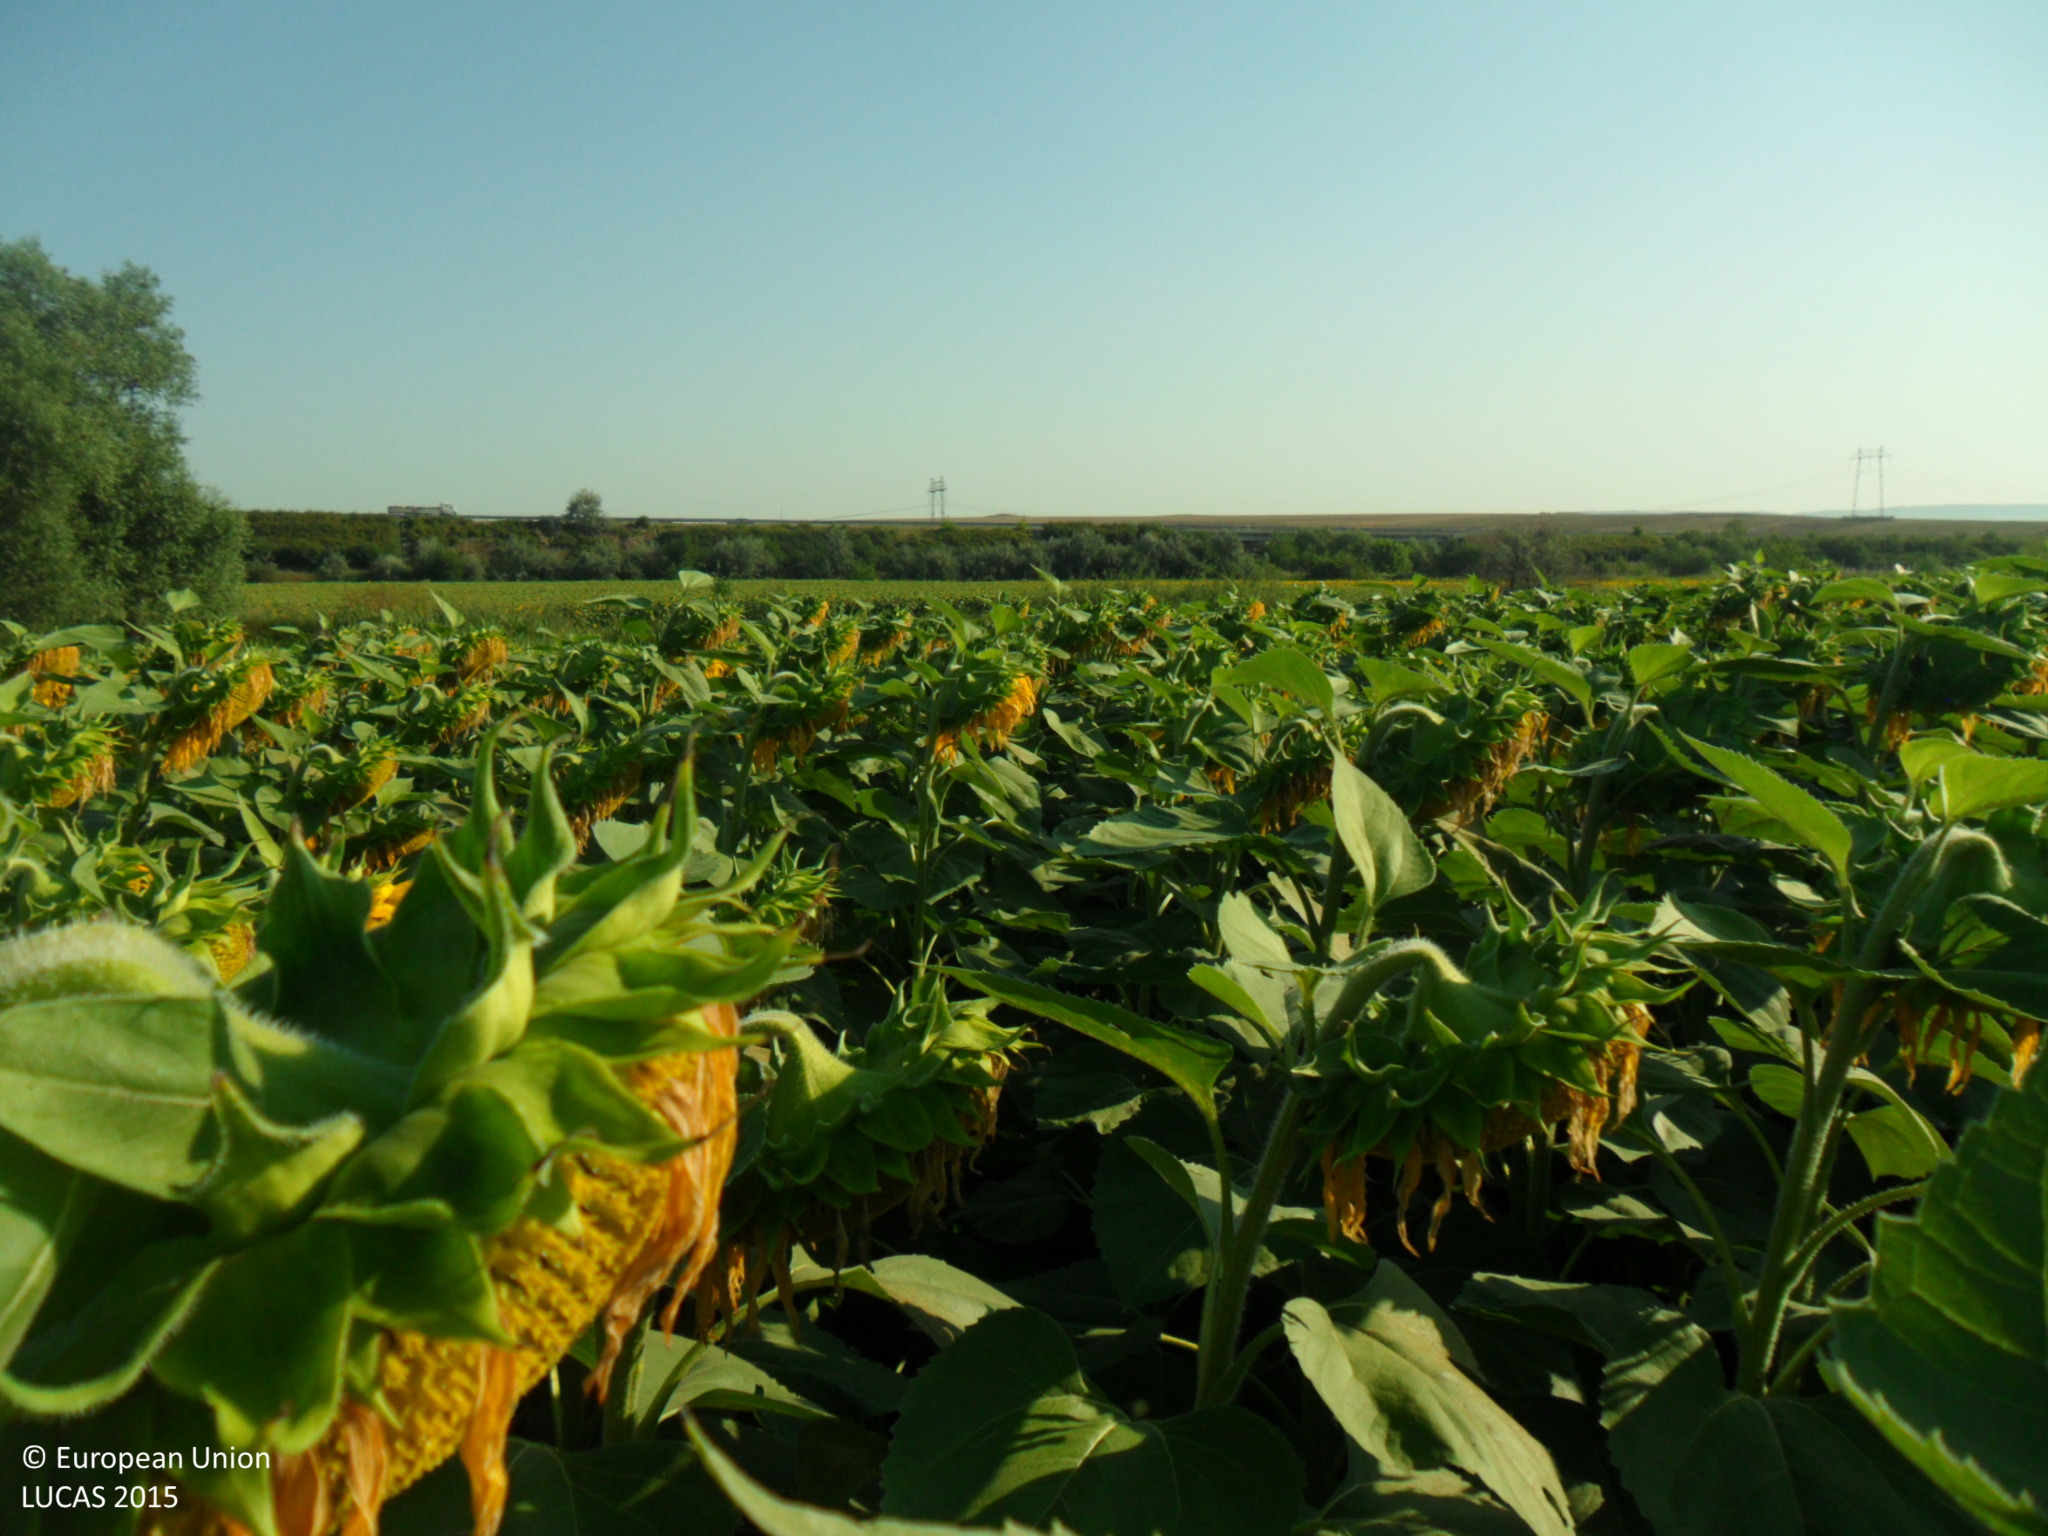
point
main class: Cropland
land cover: Sunflower
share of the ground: > 75 %
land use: Agriculture (excluding fallow land and kitchen gardens)
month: July
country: BG
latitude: 43.3194
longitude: 27.1226
